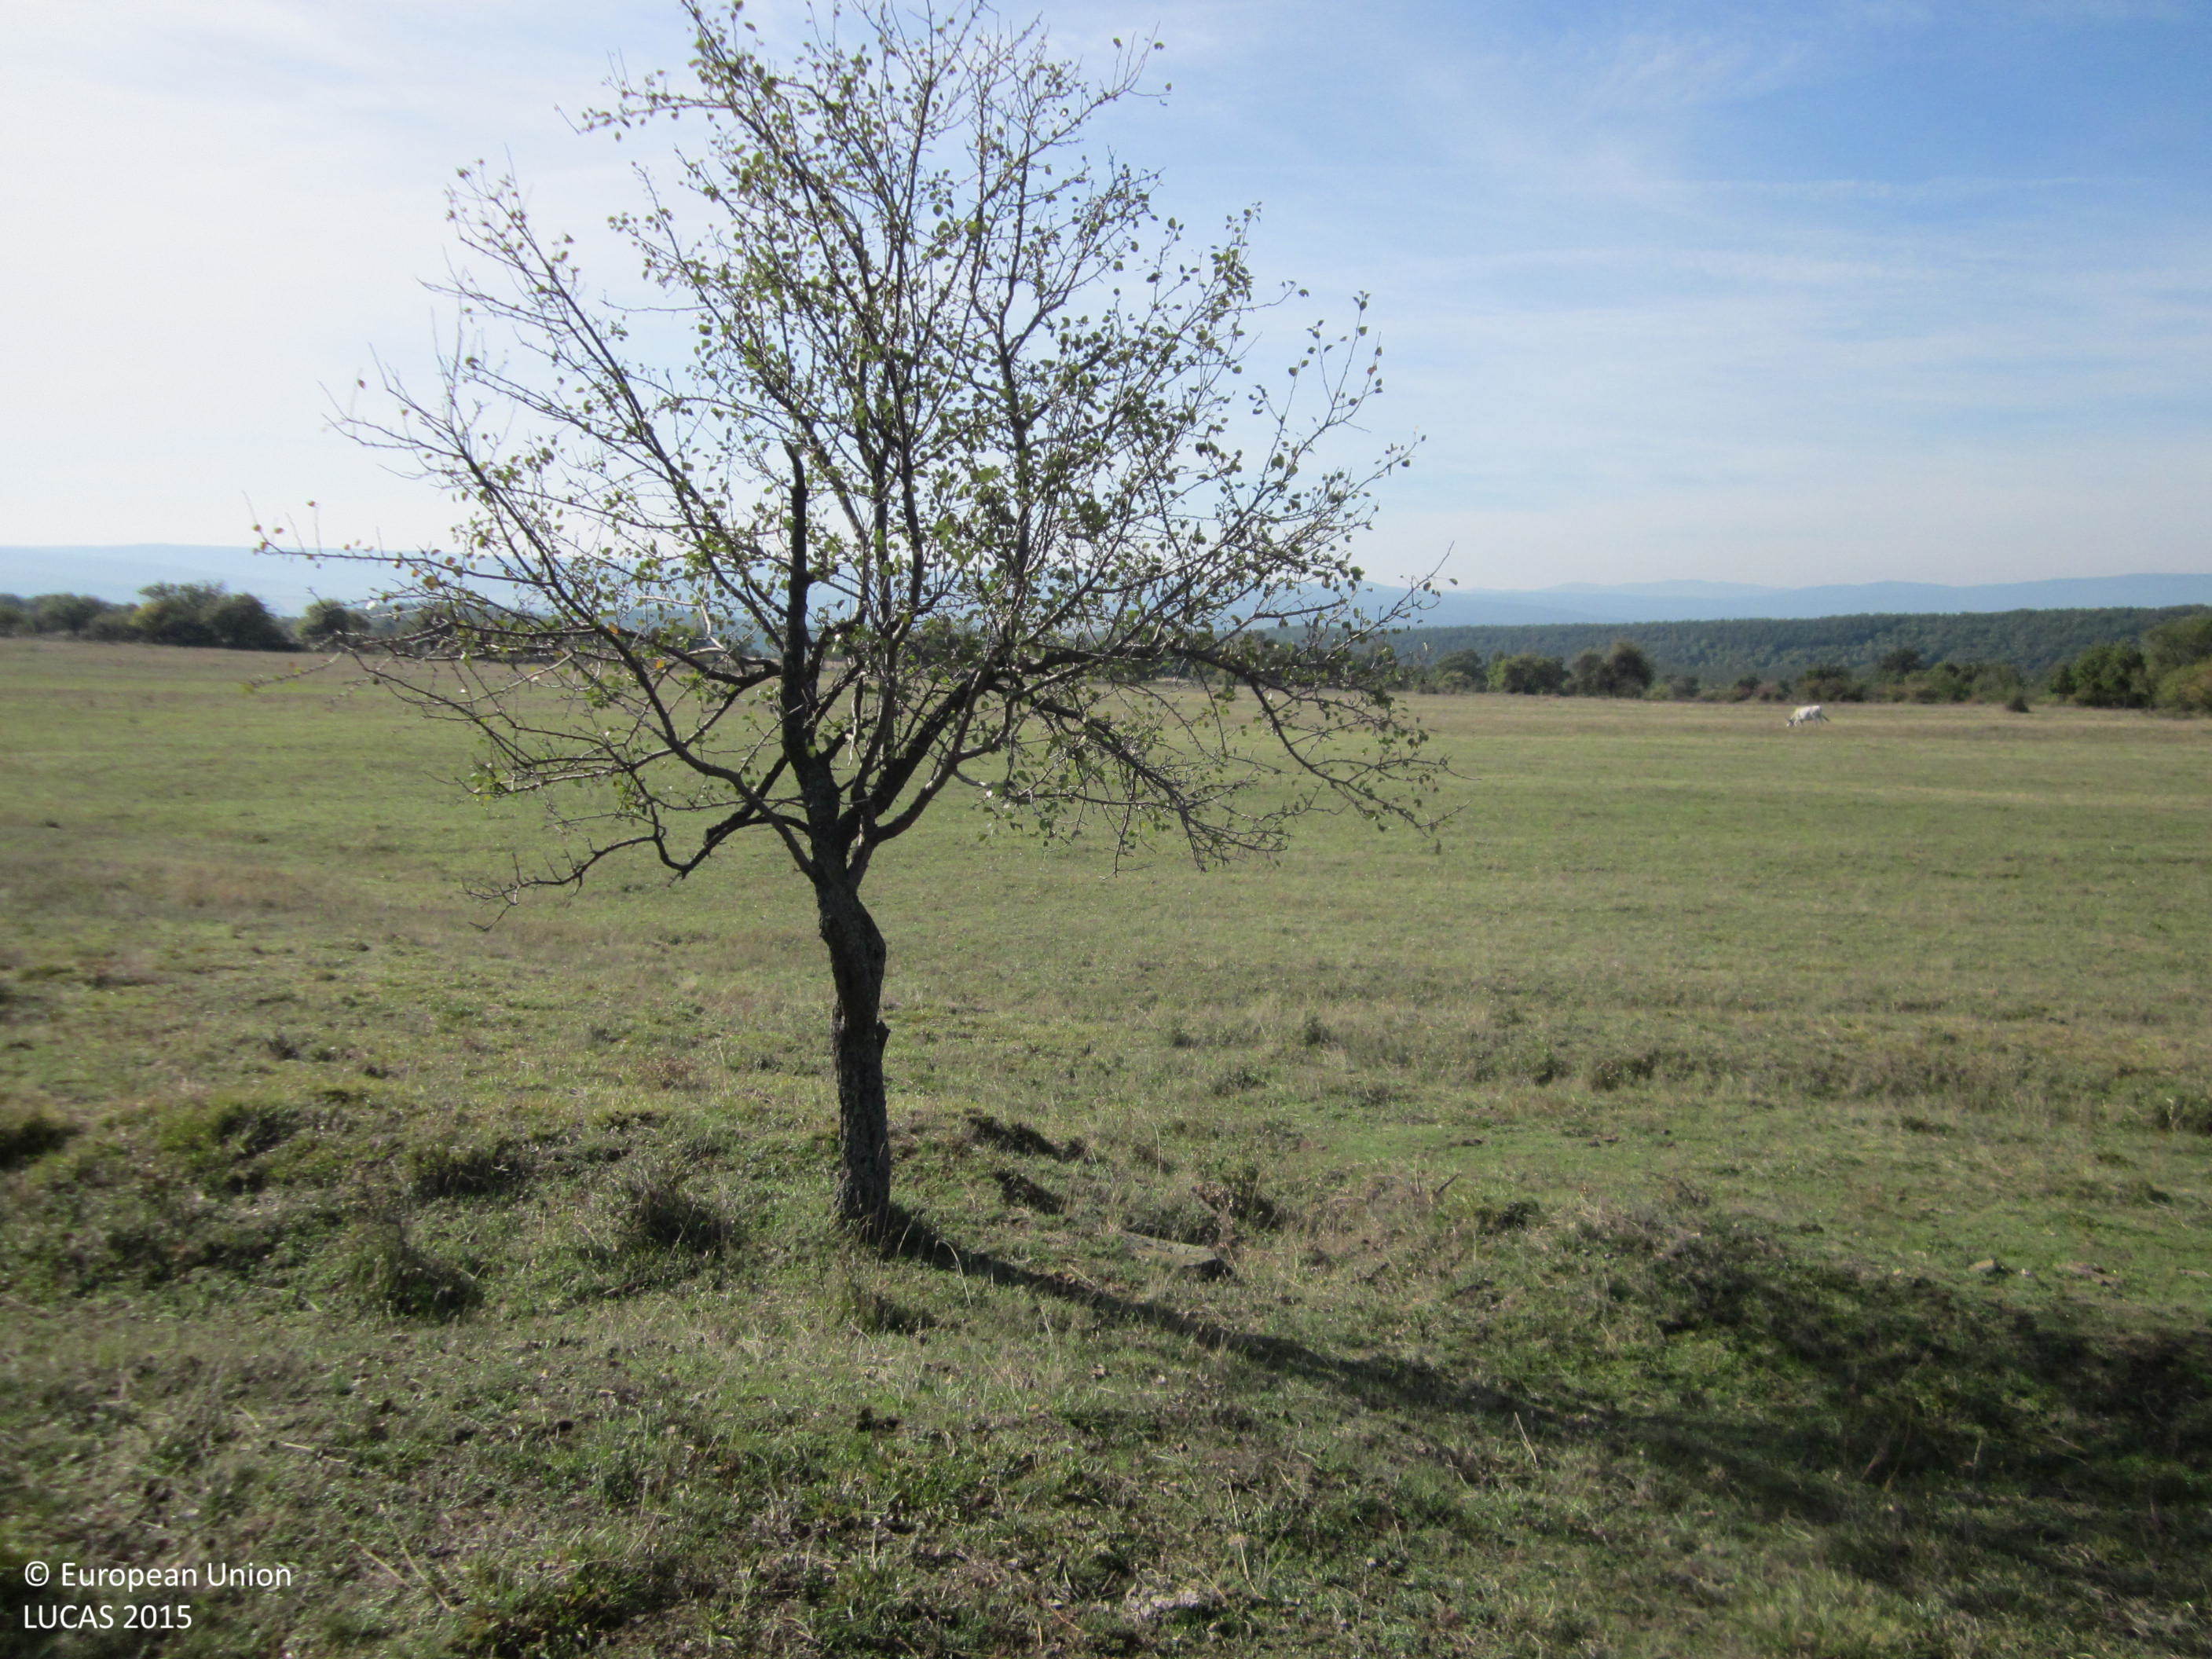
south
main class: Grassland
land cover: Grassland with sparse tree/shrub cover
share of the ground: > 75 %
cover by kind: herbaceous plants 90 %, broadleaved forest trees 5 %, shrubs 5 %
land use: Agriculture (excluding fallow land and kitchen gardens)
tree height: > 5 m
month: October
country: BG
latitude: 42.8768
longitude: 26.6901
